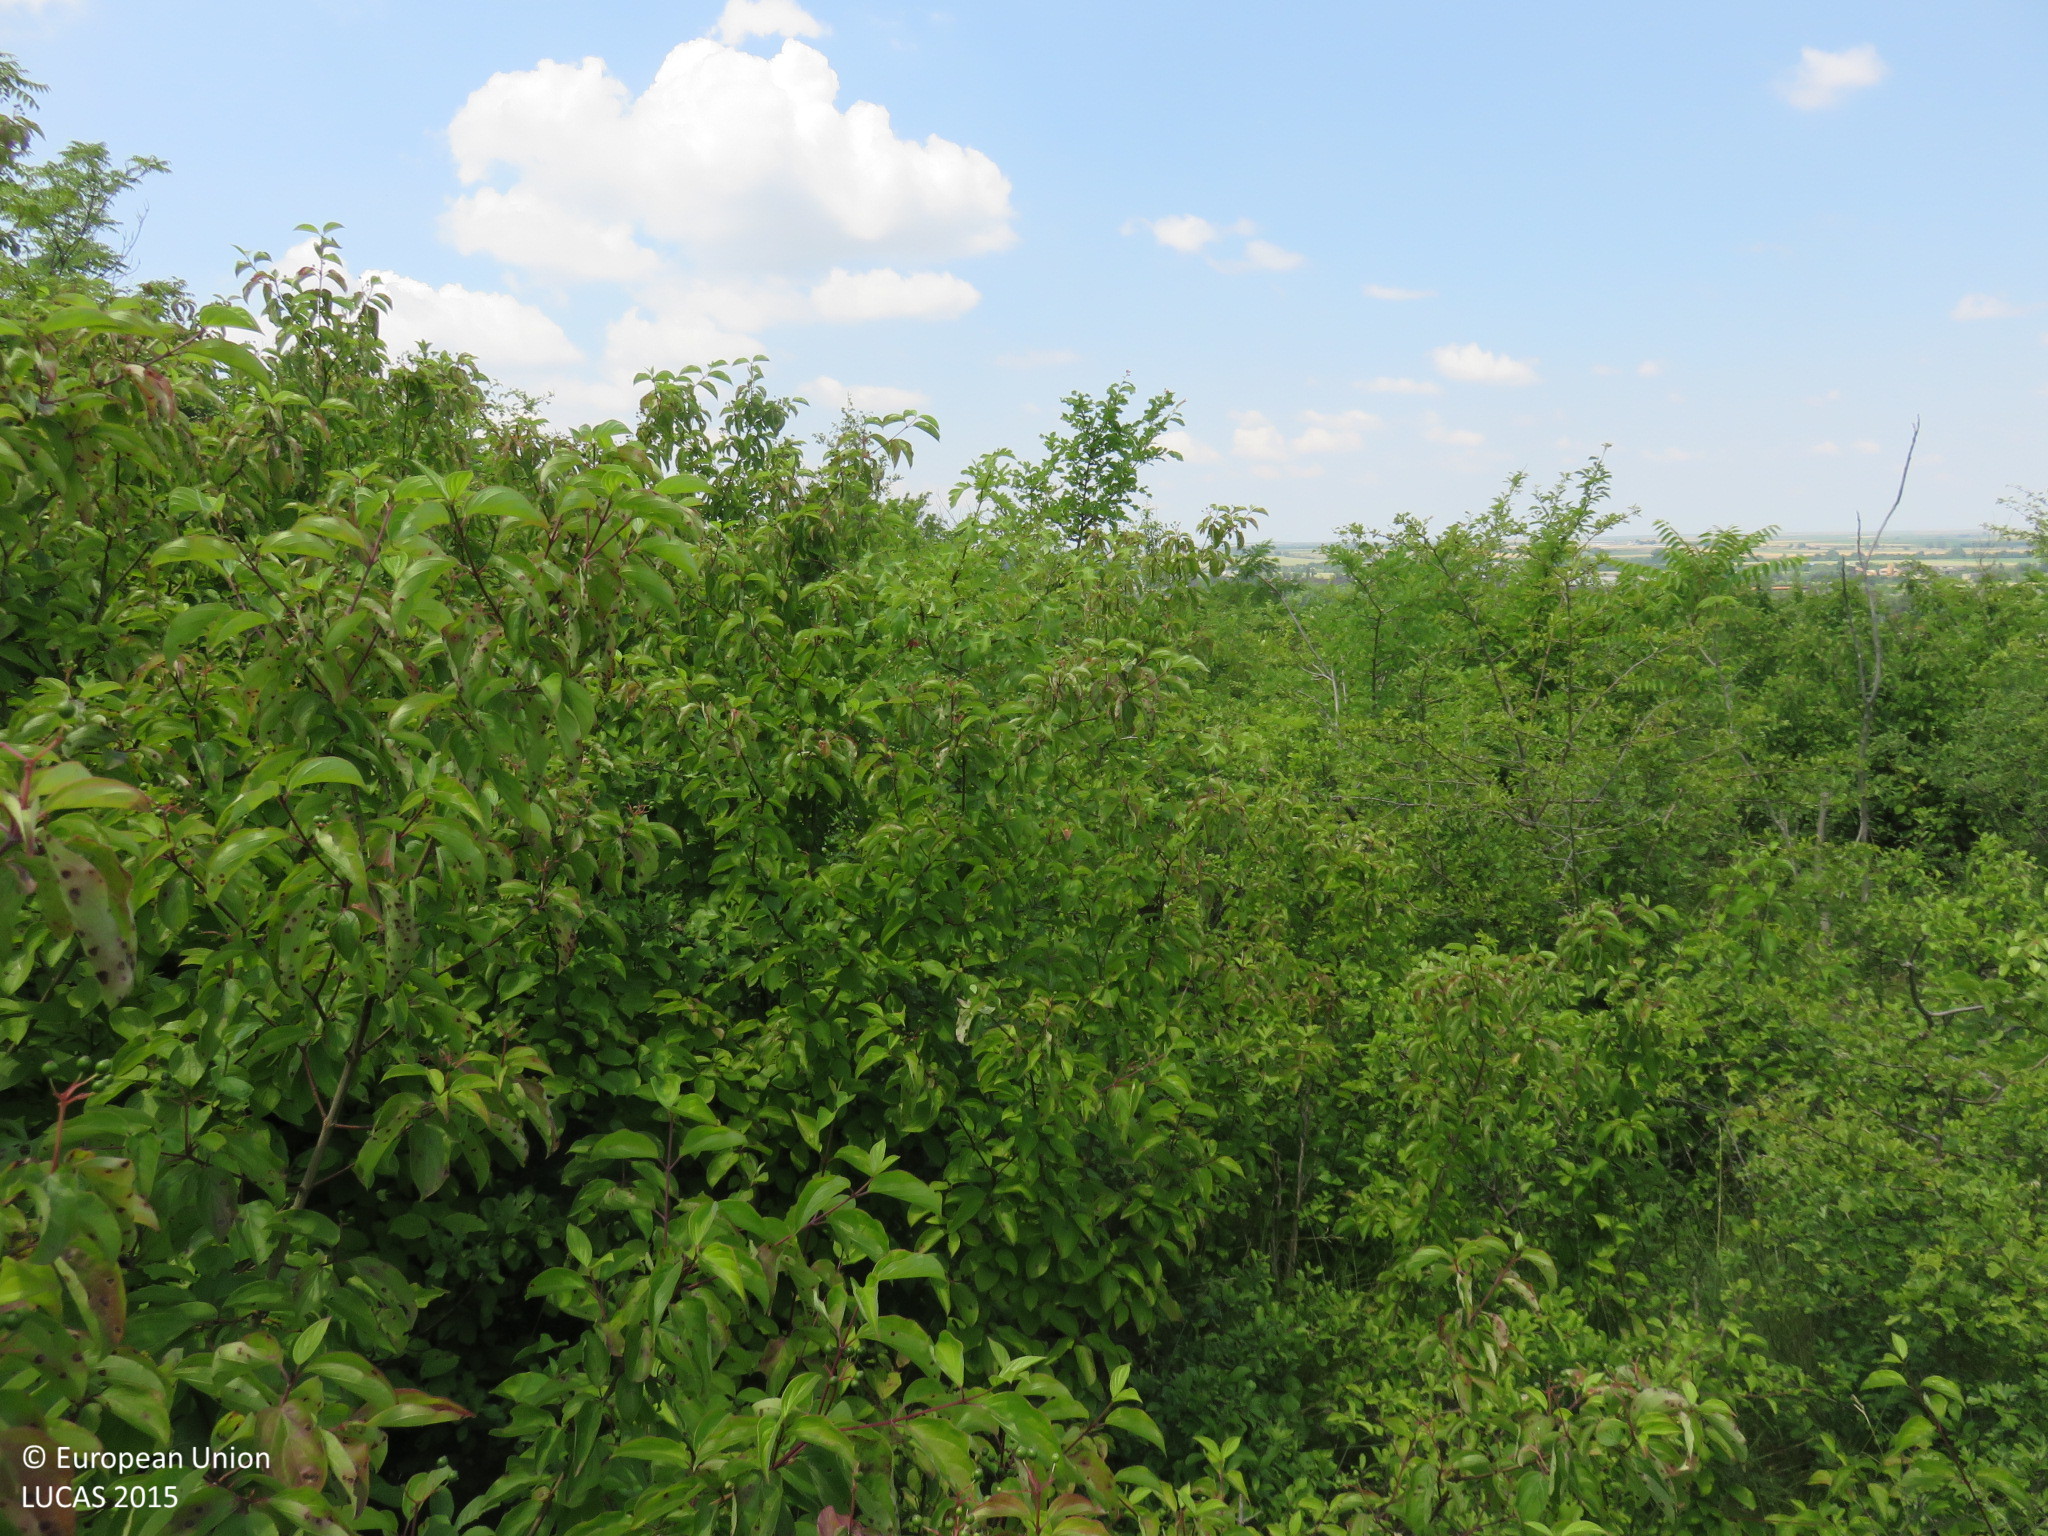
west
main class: Shrubland
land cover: Shrubland with sparse tree cover
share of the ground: > 75 %
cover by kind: shrubs 95 %, broadleaved forest trees 5 %
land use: Fallow land
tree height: < 5 m
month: June
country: BG
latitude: 43.4282
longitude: 24.5517
